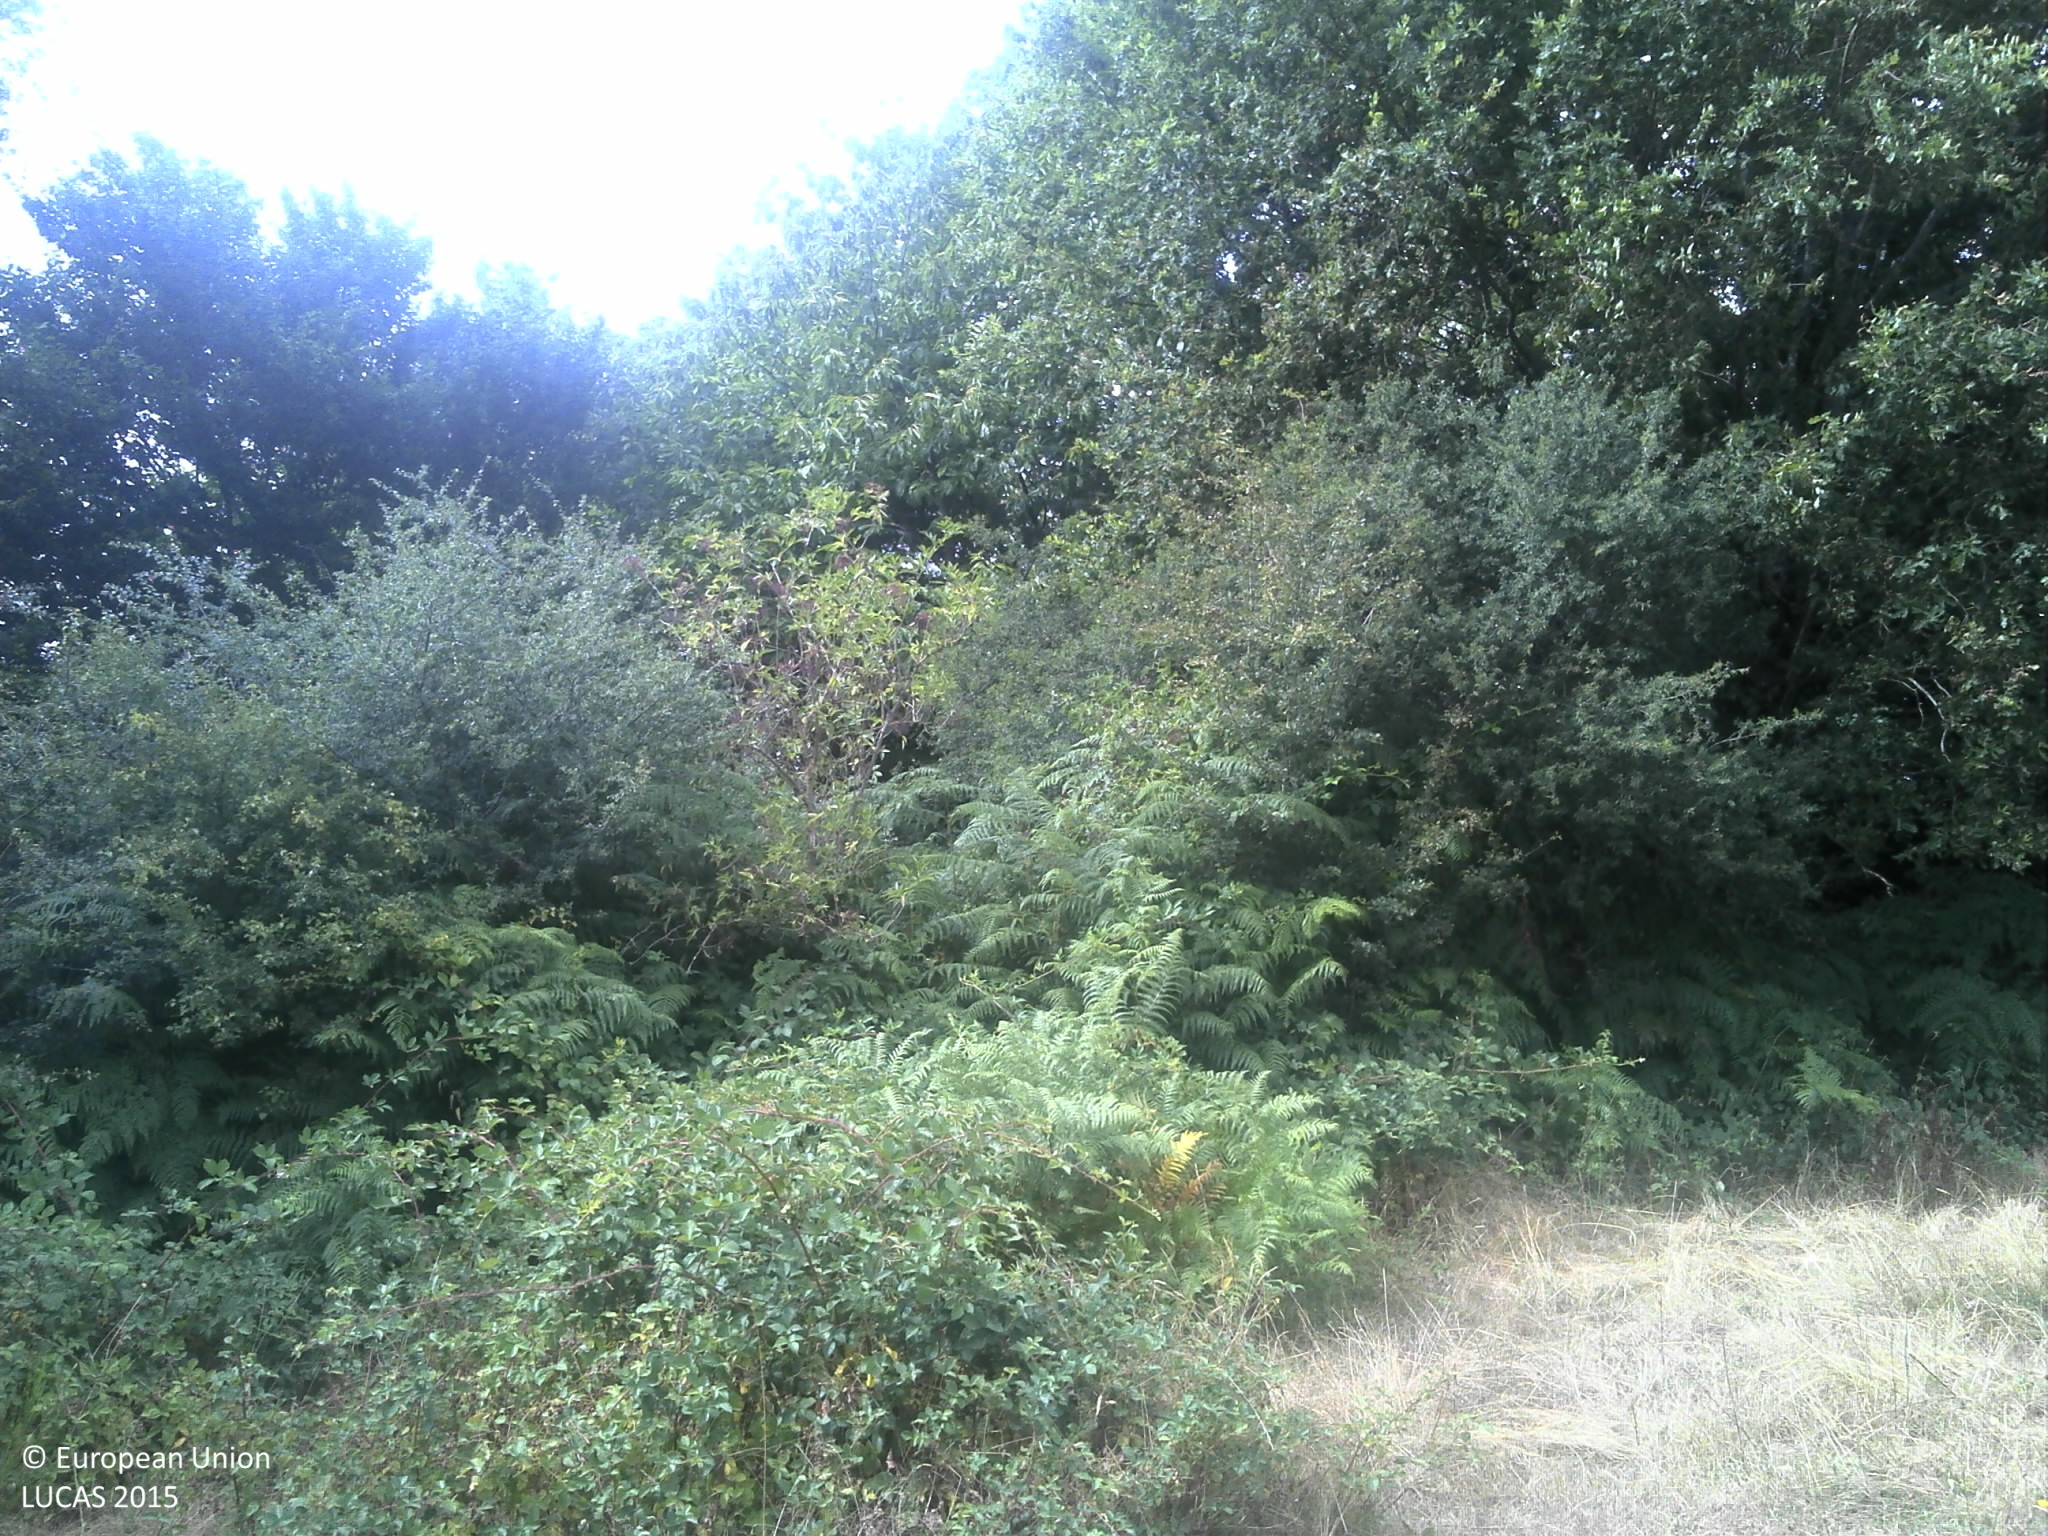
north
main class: Grassland
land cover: Grassland without tree/shrub cover
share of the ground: > 75 %
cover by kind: herbaceous plants 100 %
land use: Agriculture (excluding fallow land and kitchen gardens)
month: July
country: FR
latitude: 45.1760
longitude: 1.9169
